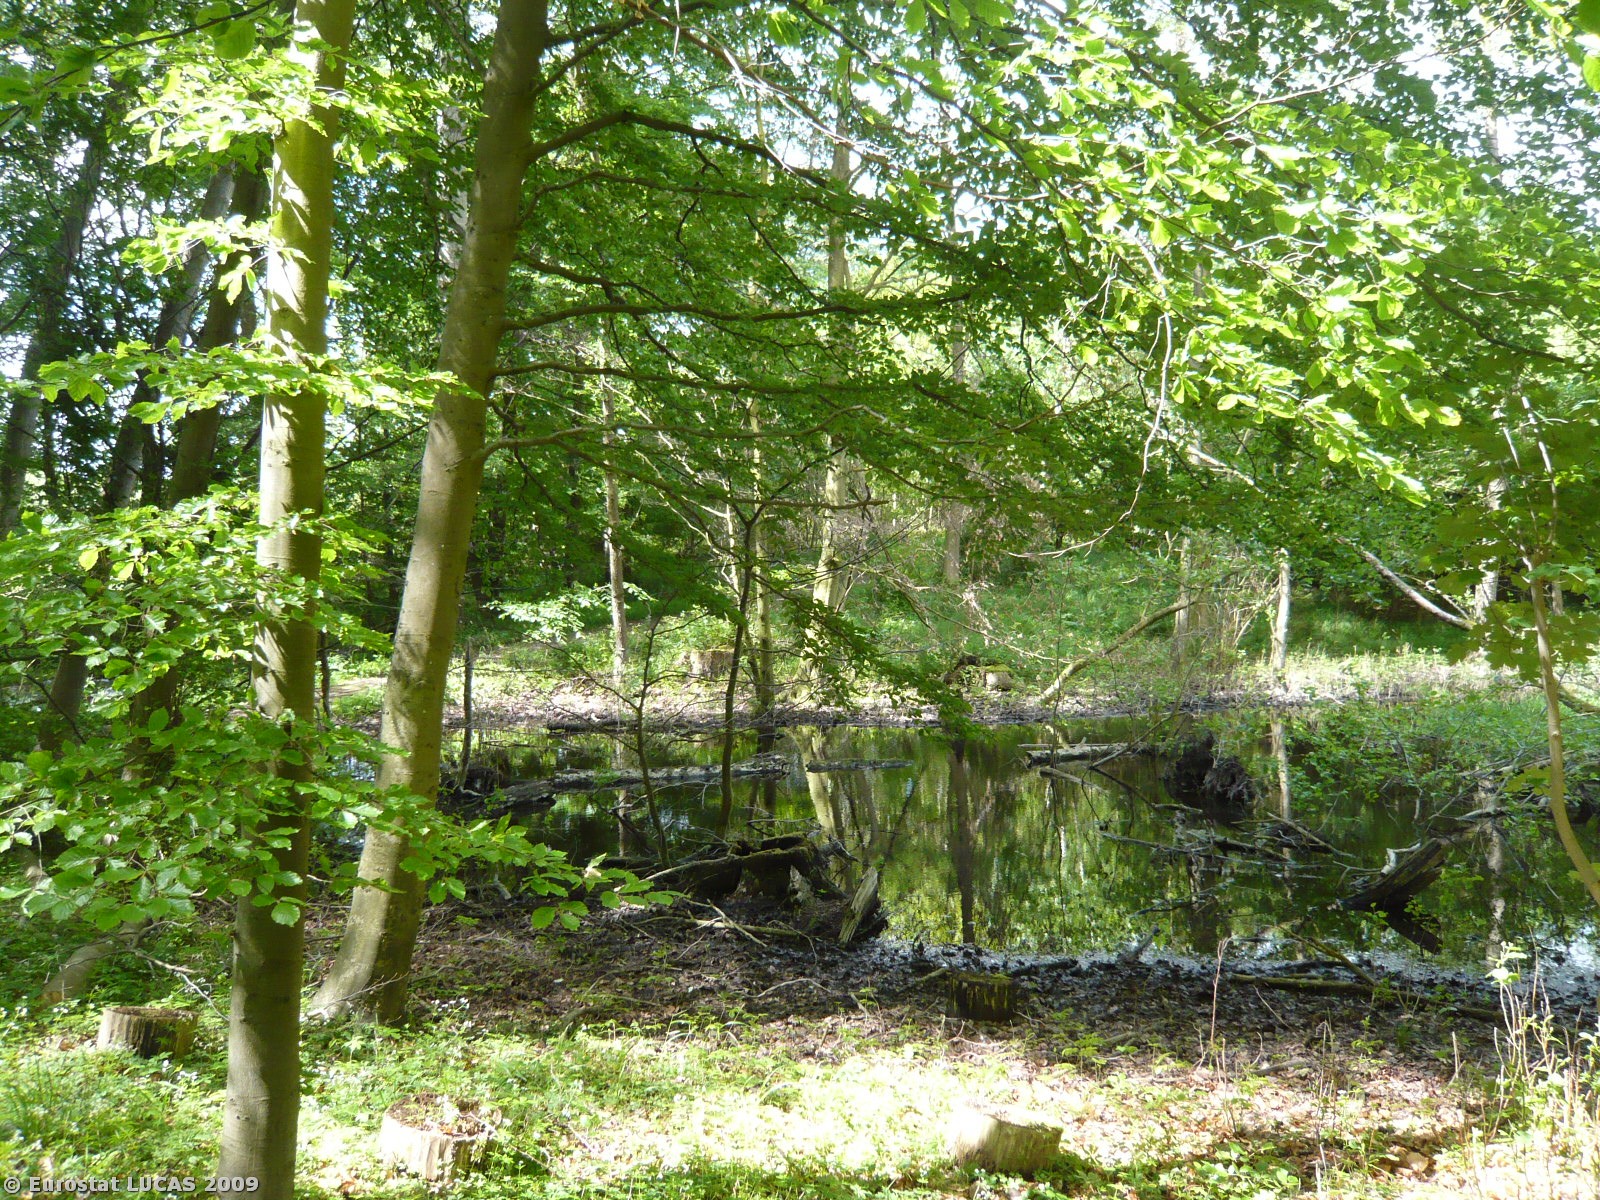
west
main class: Woodland
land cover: Broadleaved woodland
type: mesophytic deciduous forest
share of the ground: > 75 %
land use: Forestry
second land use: Amenities, museums, leisure
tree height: > 5 m
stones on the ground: < 10 %
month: May
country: DK
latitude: 55.6340
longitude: 11.9204
